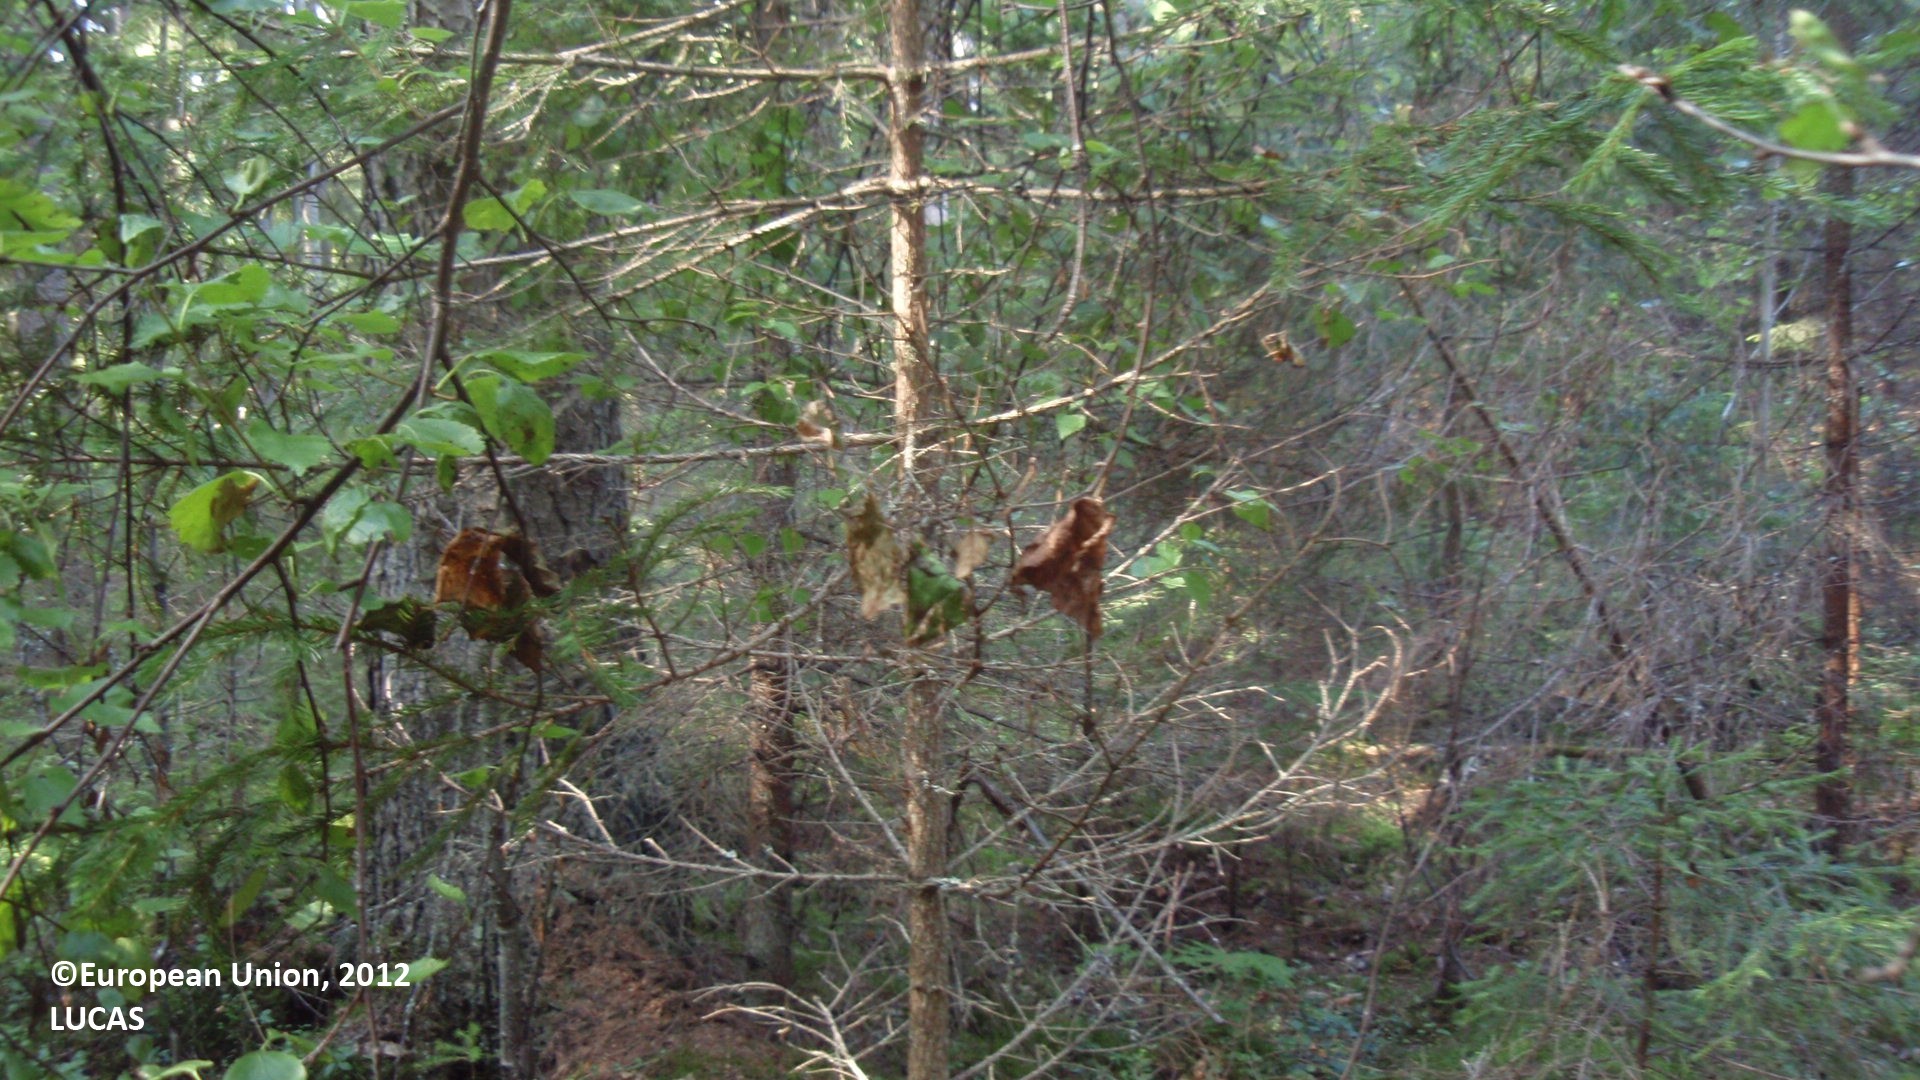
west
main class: Woodland
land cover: Spruce dominated coniferous woodland
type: boreal forest
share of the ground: > 75 %
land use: Forestry
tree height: > 5 m
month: August
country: FI
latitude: 60.6204
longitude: 27.4145
